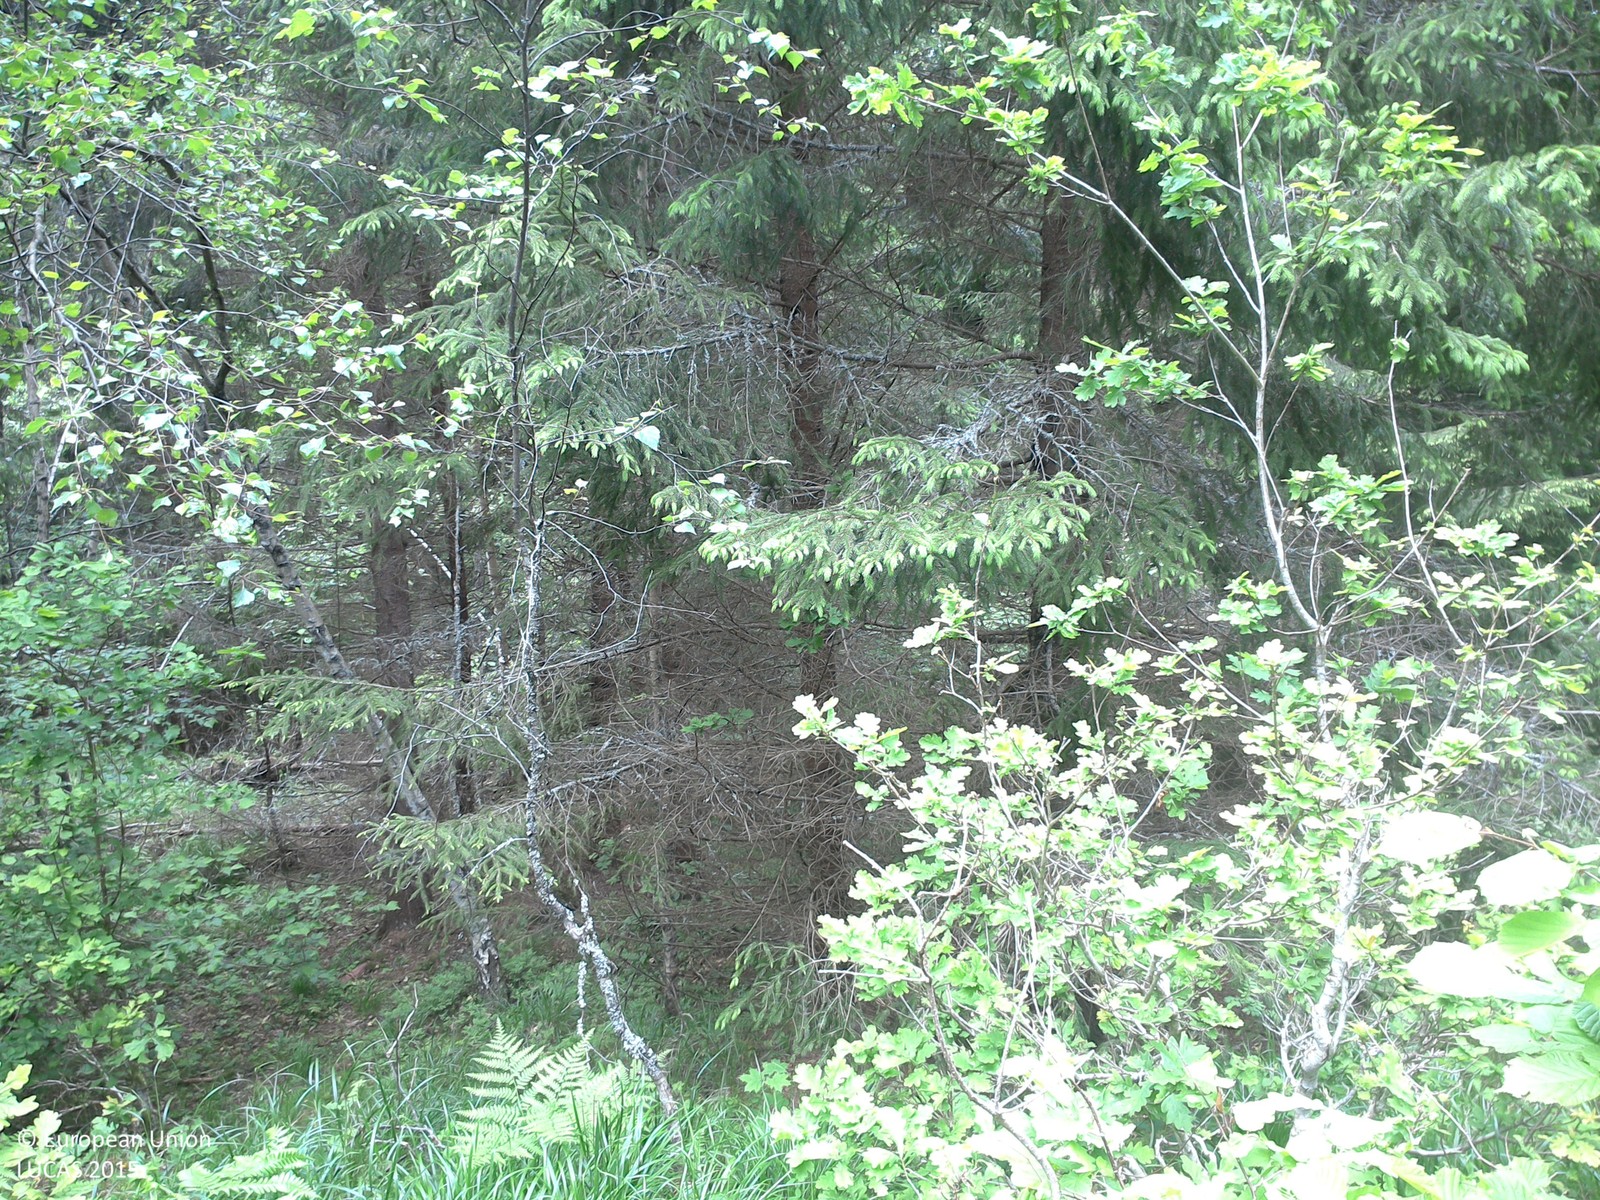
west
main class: Woodland
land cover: Spruce dominated mixed woodland
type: boreal forest
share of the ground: 50 - 75 %
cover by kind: coniferous forest trees 50 %, broadleaved forest trees 20 %, herbaceous plants 15 %, lichens and mosses 15 %
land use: Amenities, museums, leisure
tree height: > 5 m
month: June
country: SE
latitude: 58.0721
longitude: 15.4712
